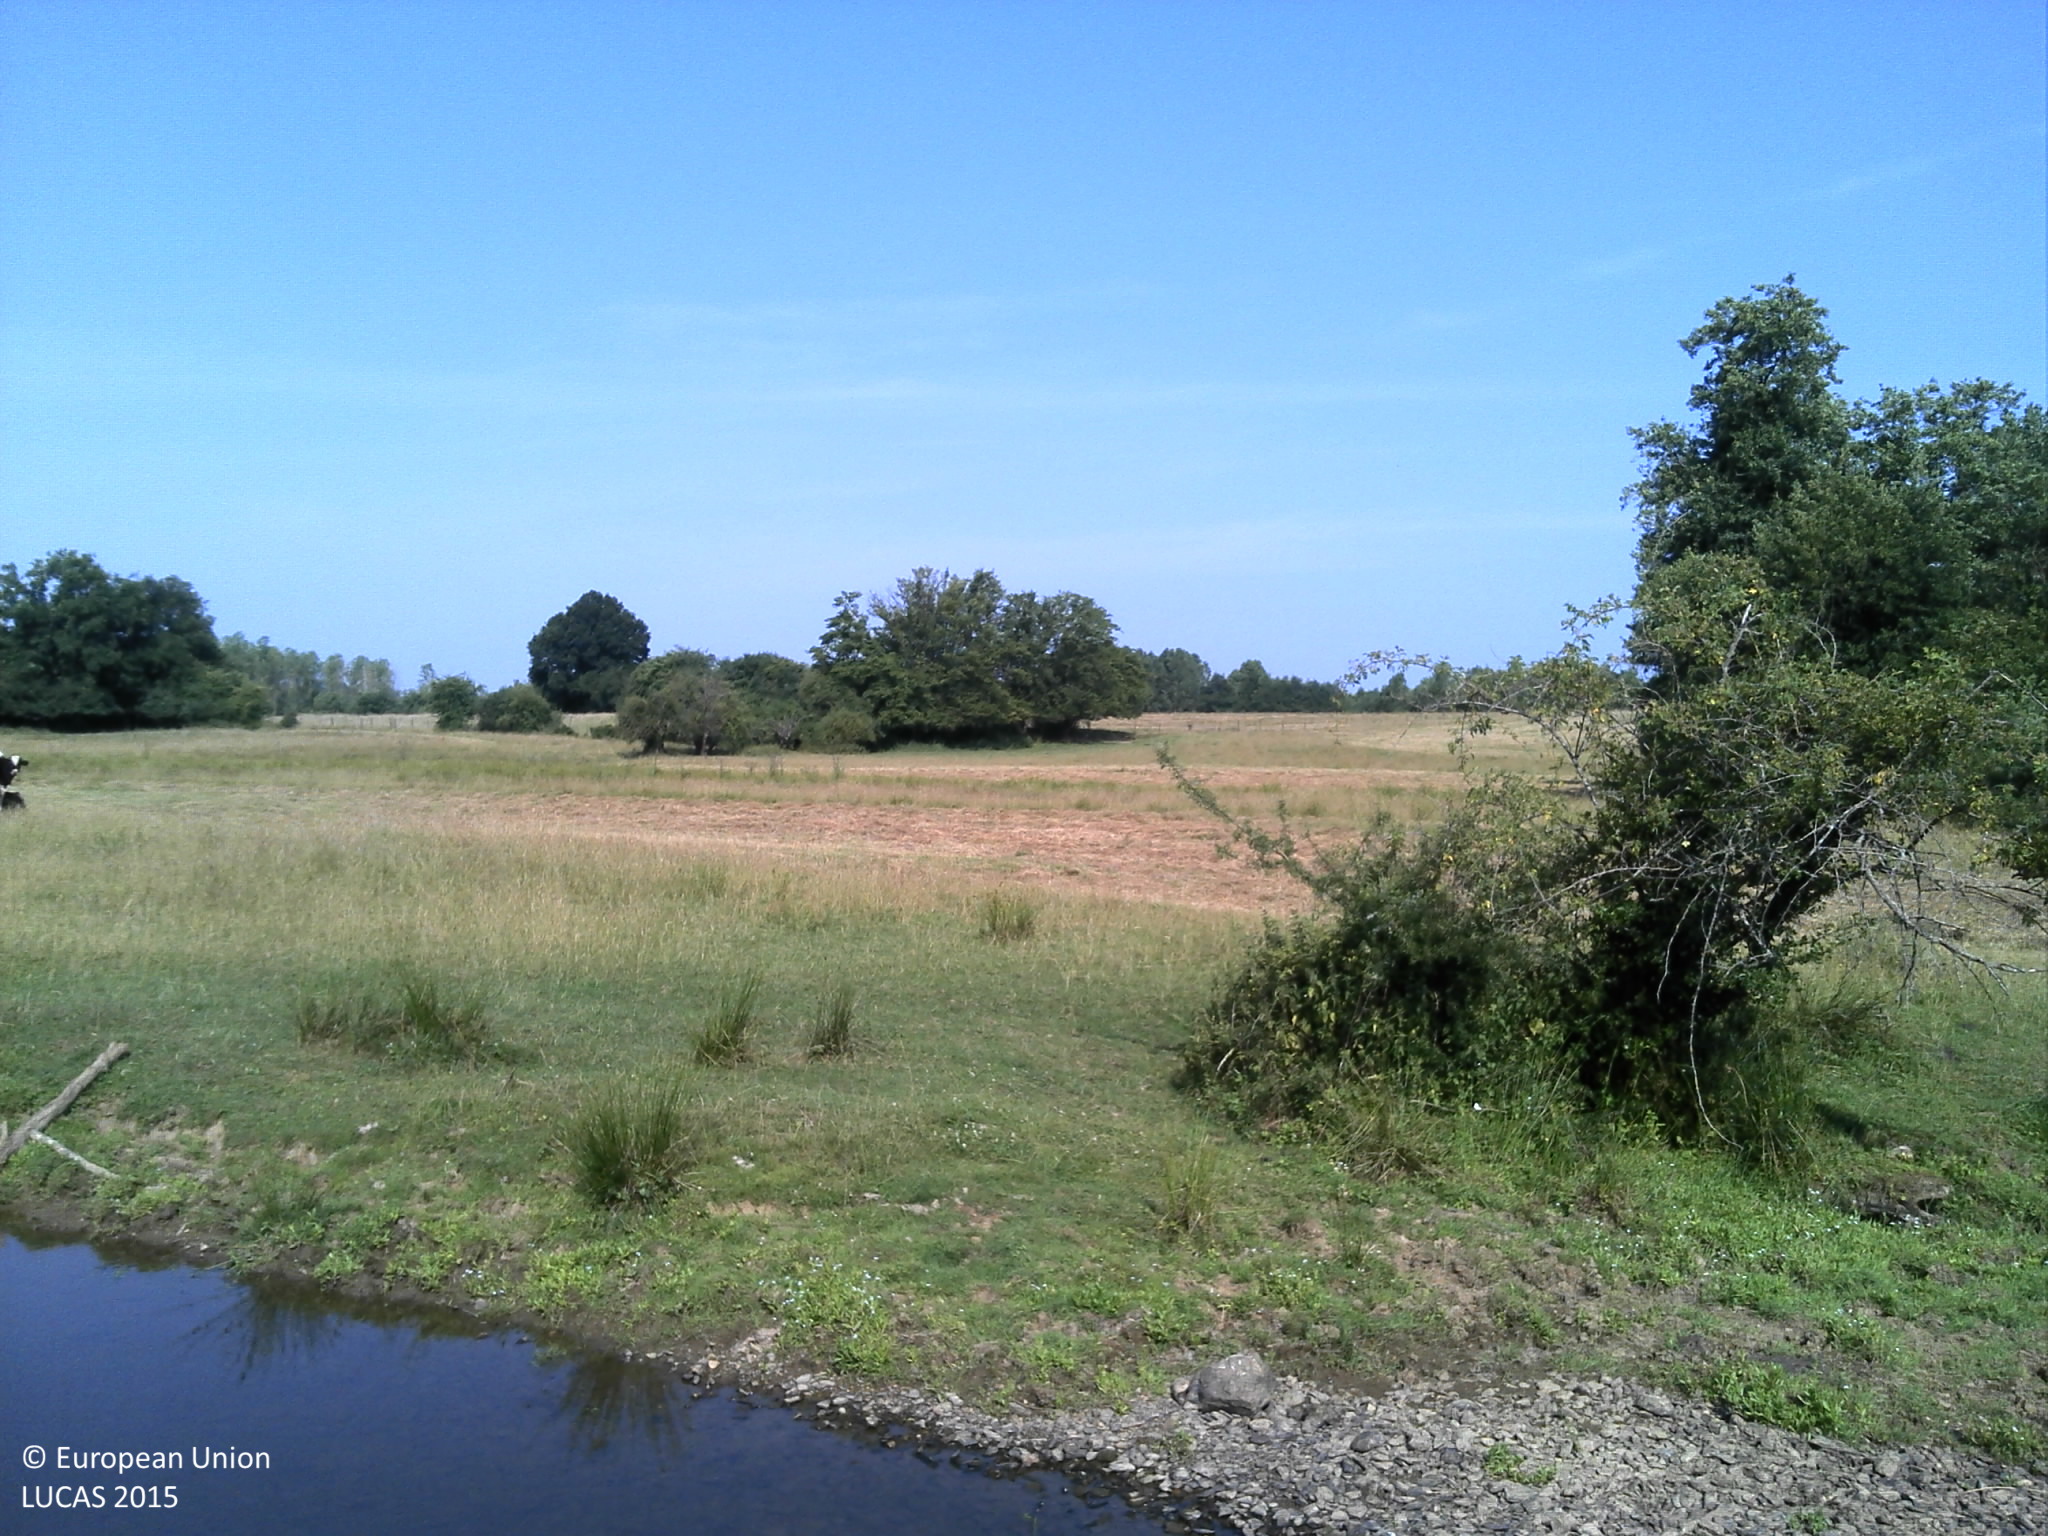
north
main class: Grassland
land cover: Grassland without tree/shrub cover
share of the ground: > 75 %
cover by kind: herbaceous plants 100 %
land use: Agriculture (excluding fallow land and kitchen gardens)
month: July
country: FR
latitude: 49.8341
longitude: 4.4764
